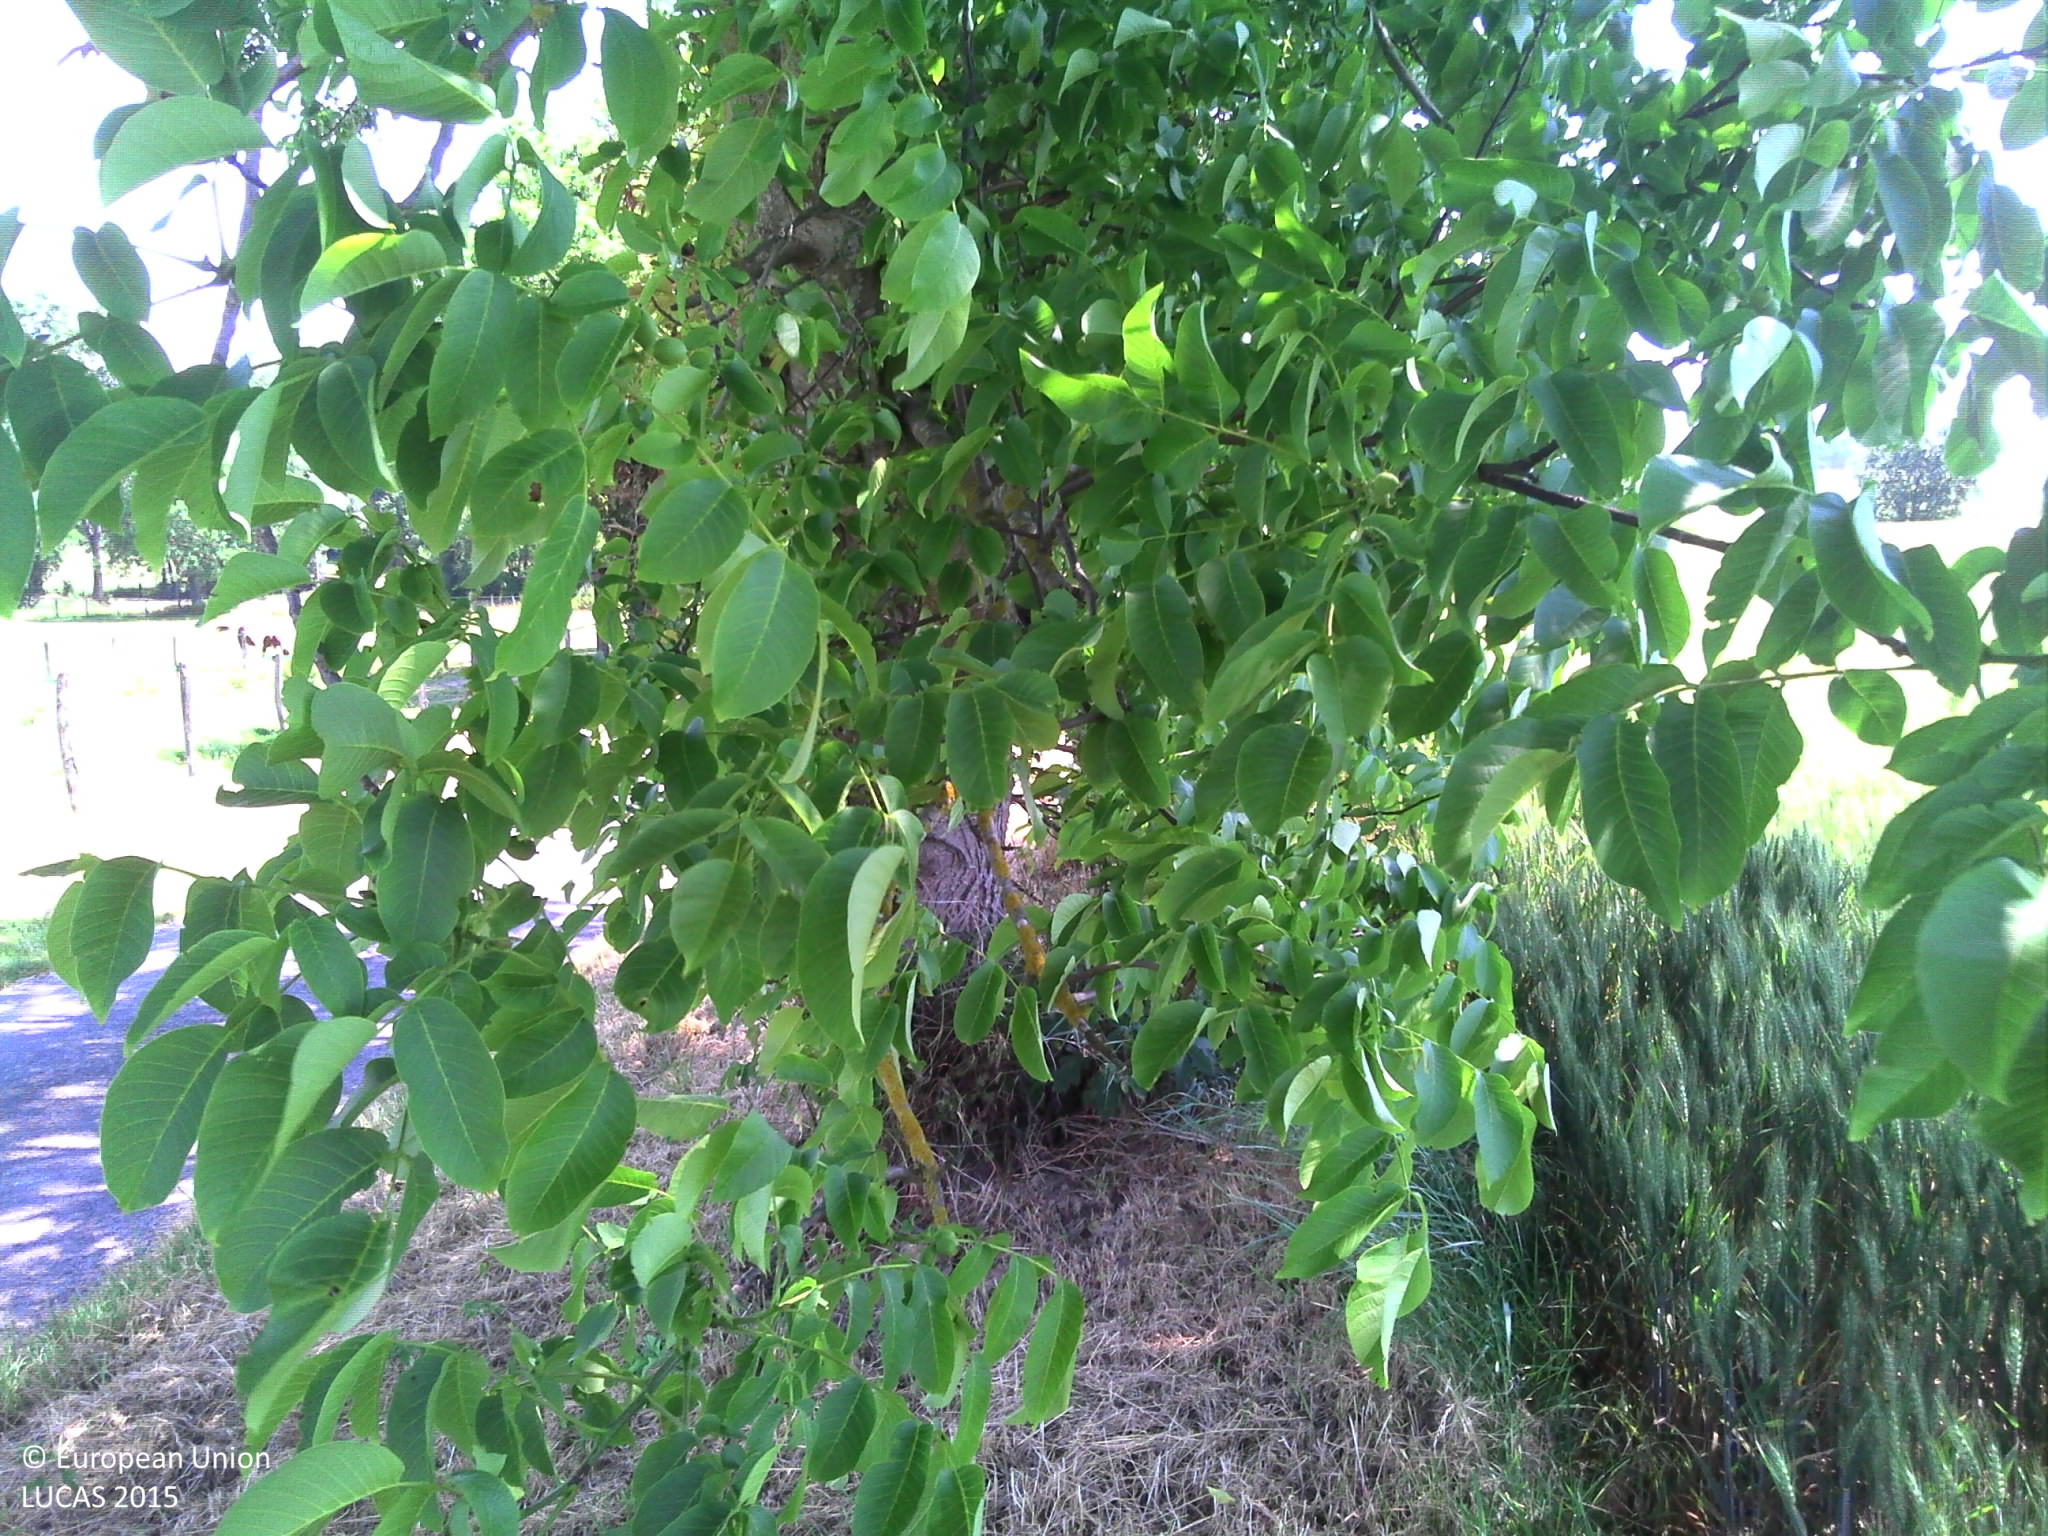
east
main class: Cropland
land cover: Durum wheat
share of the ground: > 75 %
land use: Agriculture (excluding fallow land and kitchen gardens)
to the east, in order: Durum wheat; Lines of trees; Ditches and canals; Spontaneously vegetated surfaces; Rape and turnip rape
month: June
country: FR
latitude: 45.9926
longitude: 4.8517
